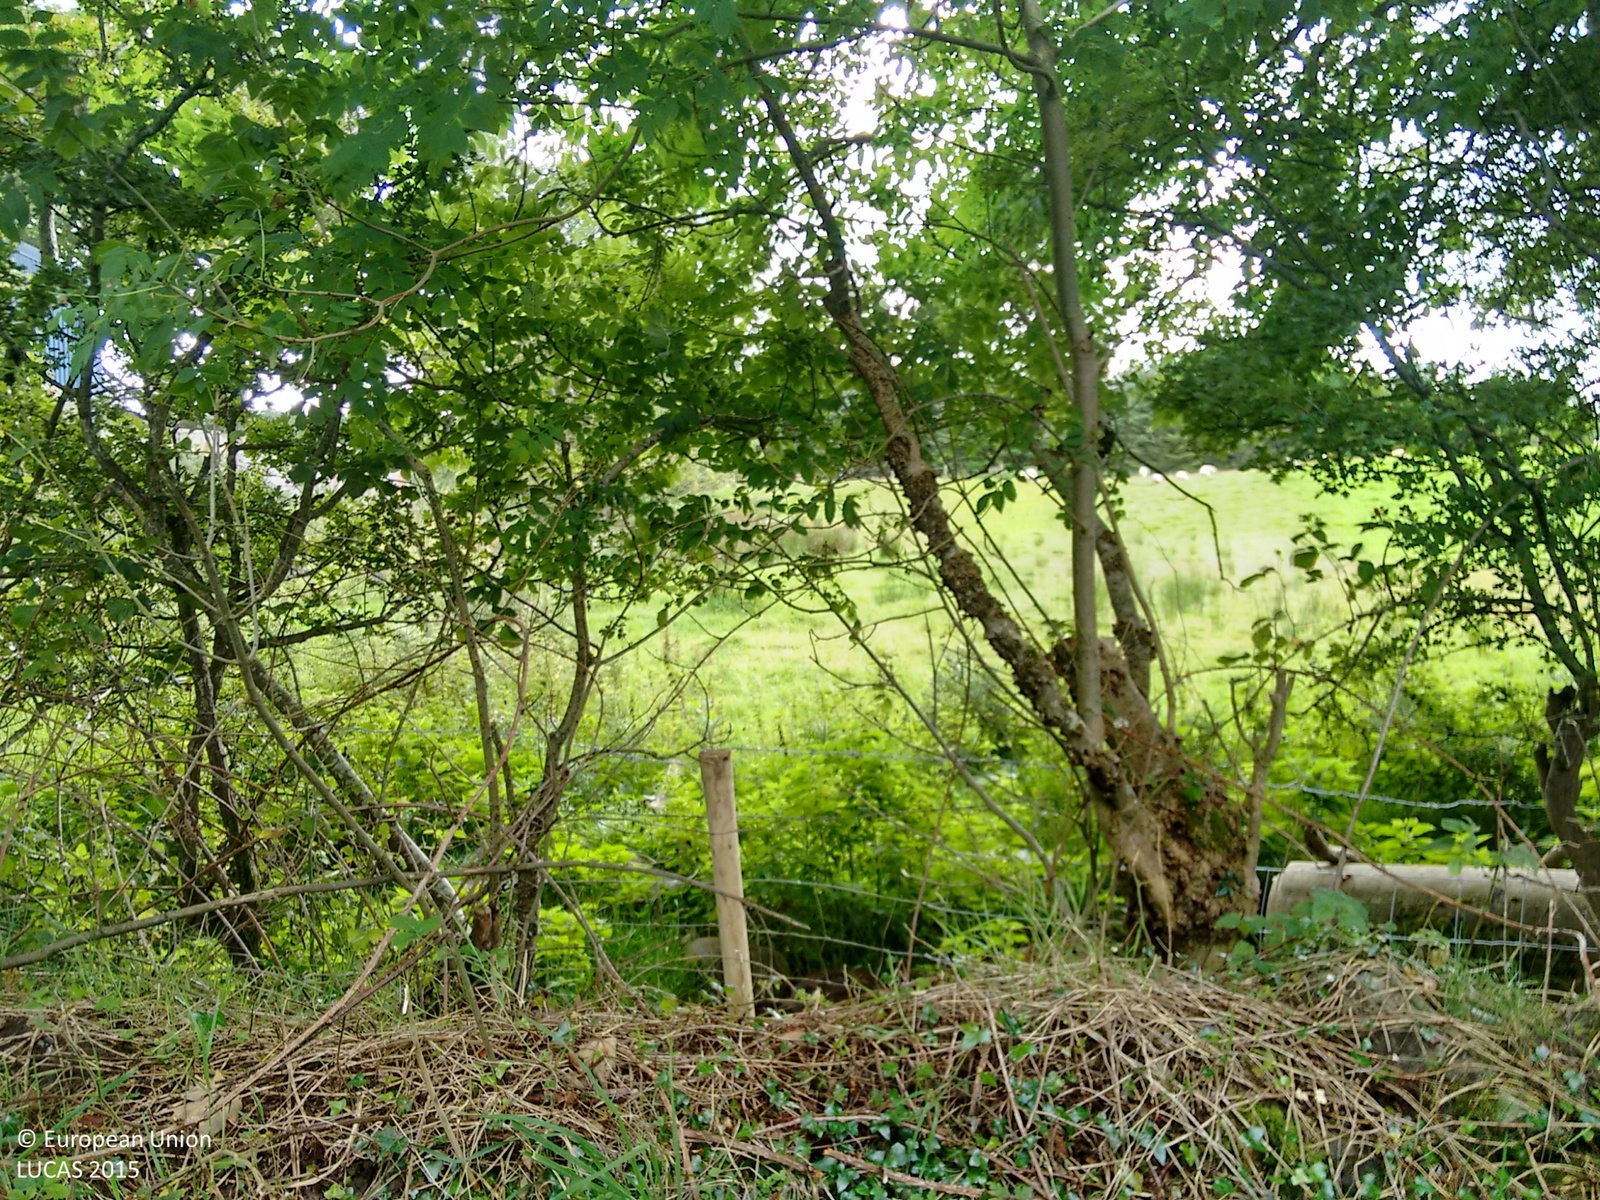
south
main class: Grassland
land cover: Grassland without tree/shrub cover
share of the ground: > 75 %
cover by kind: herbaceous plants 100 %
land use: Agriculture (excluding fallow land and kitchen gardens)
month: September
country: IE
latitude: 55.2247
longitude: -7.2657
